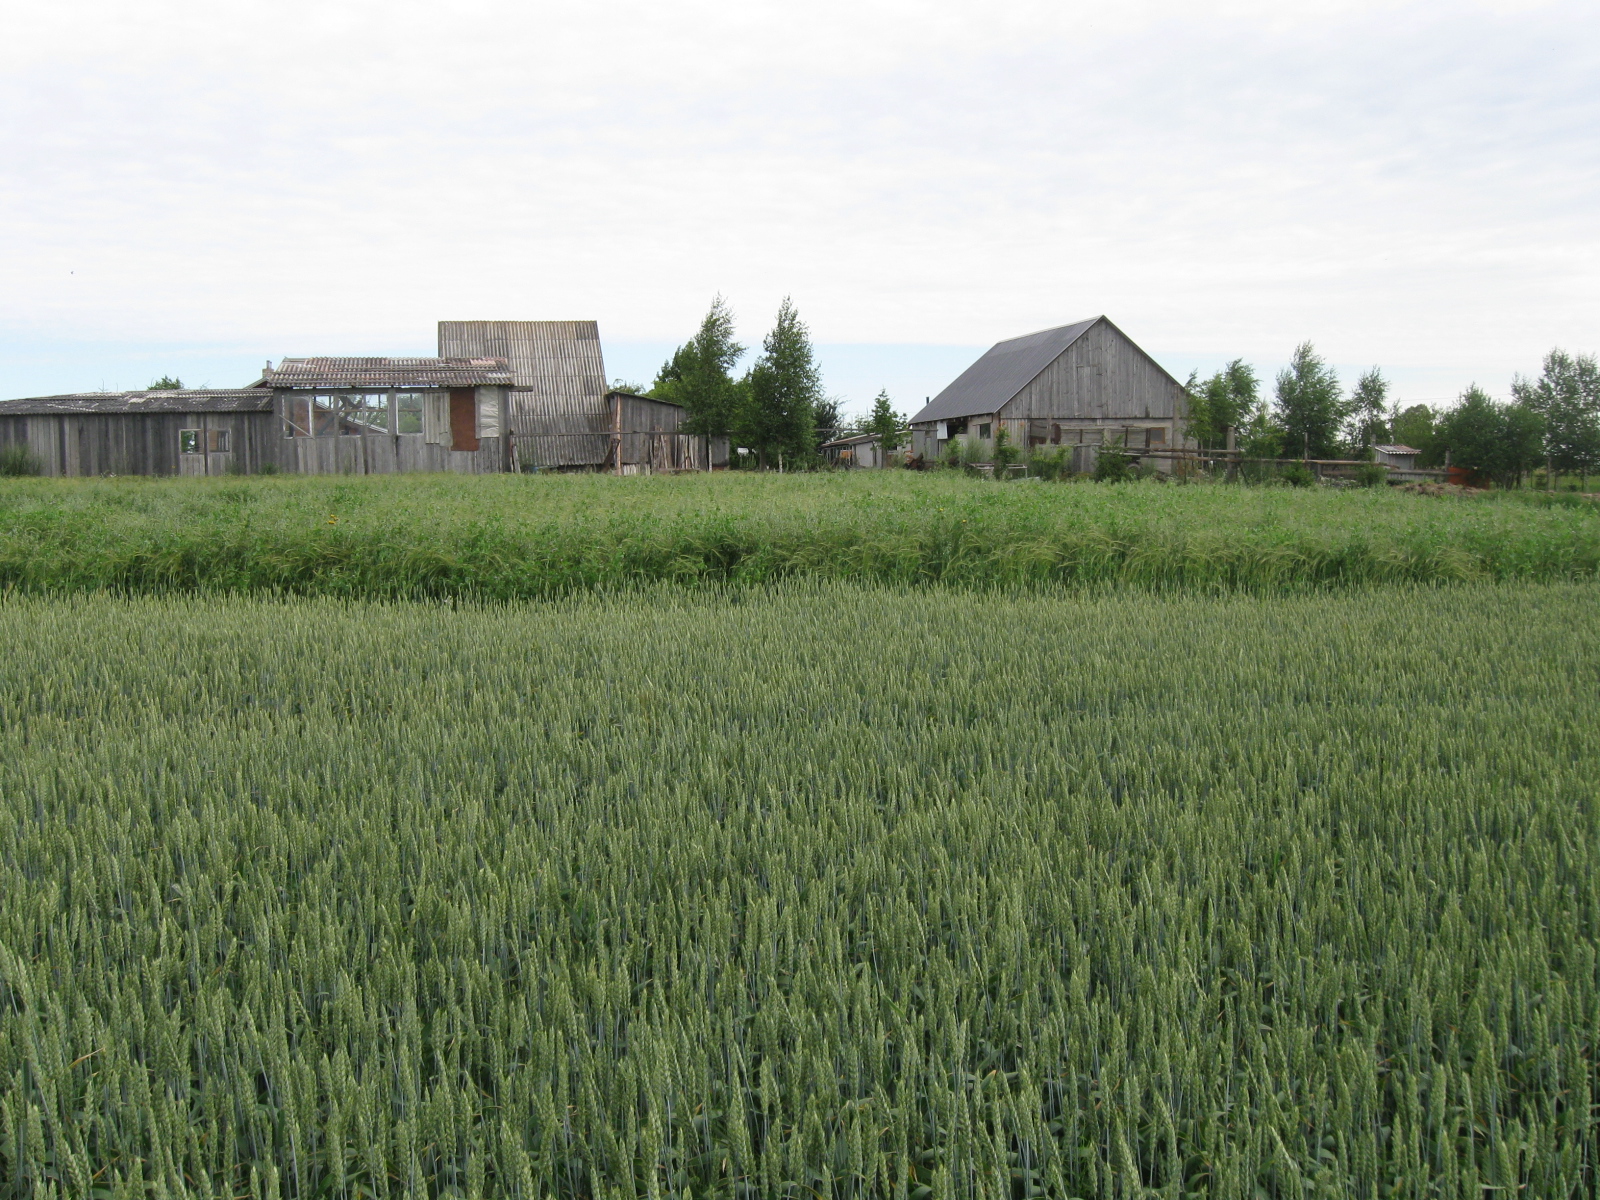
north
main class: Cropland
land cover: Common wheat
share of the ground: > 75 %
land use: Agriculture (excluding fallow land and kitchen gardens)
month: July
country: LT
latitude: 55.0338
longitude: 23.6487
